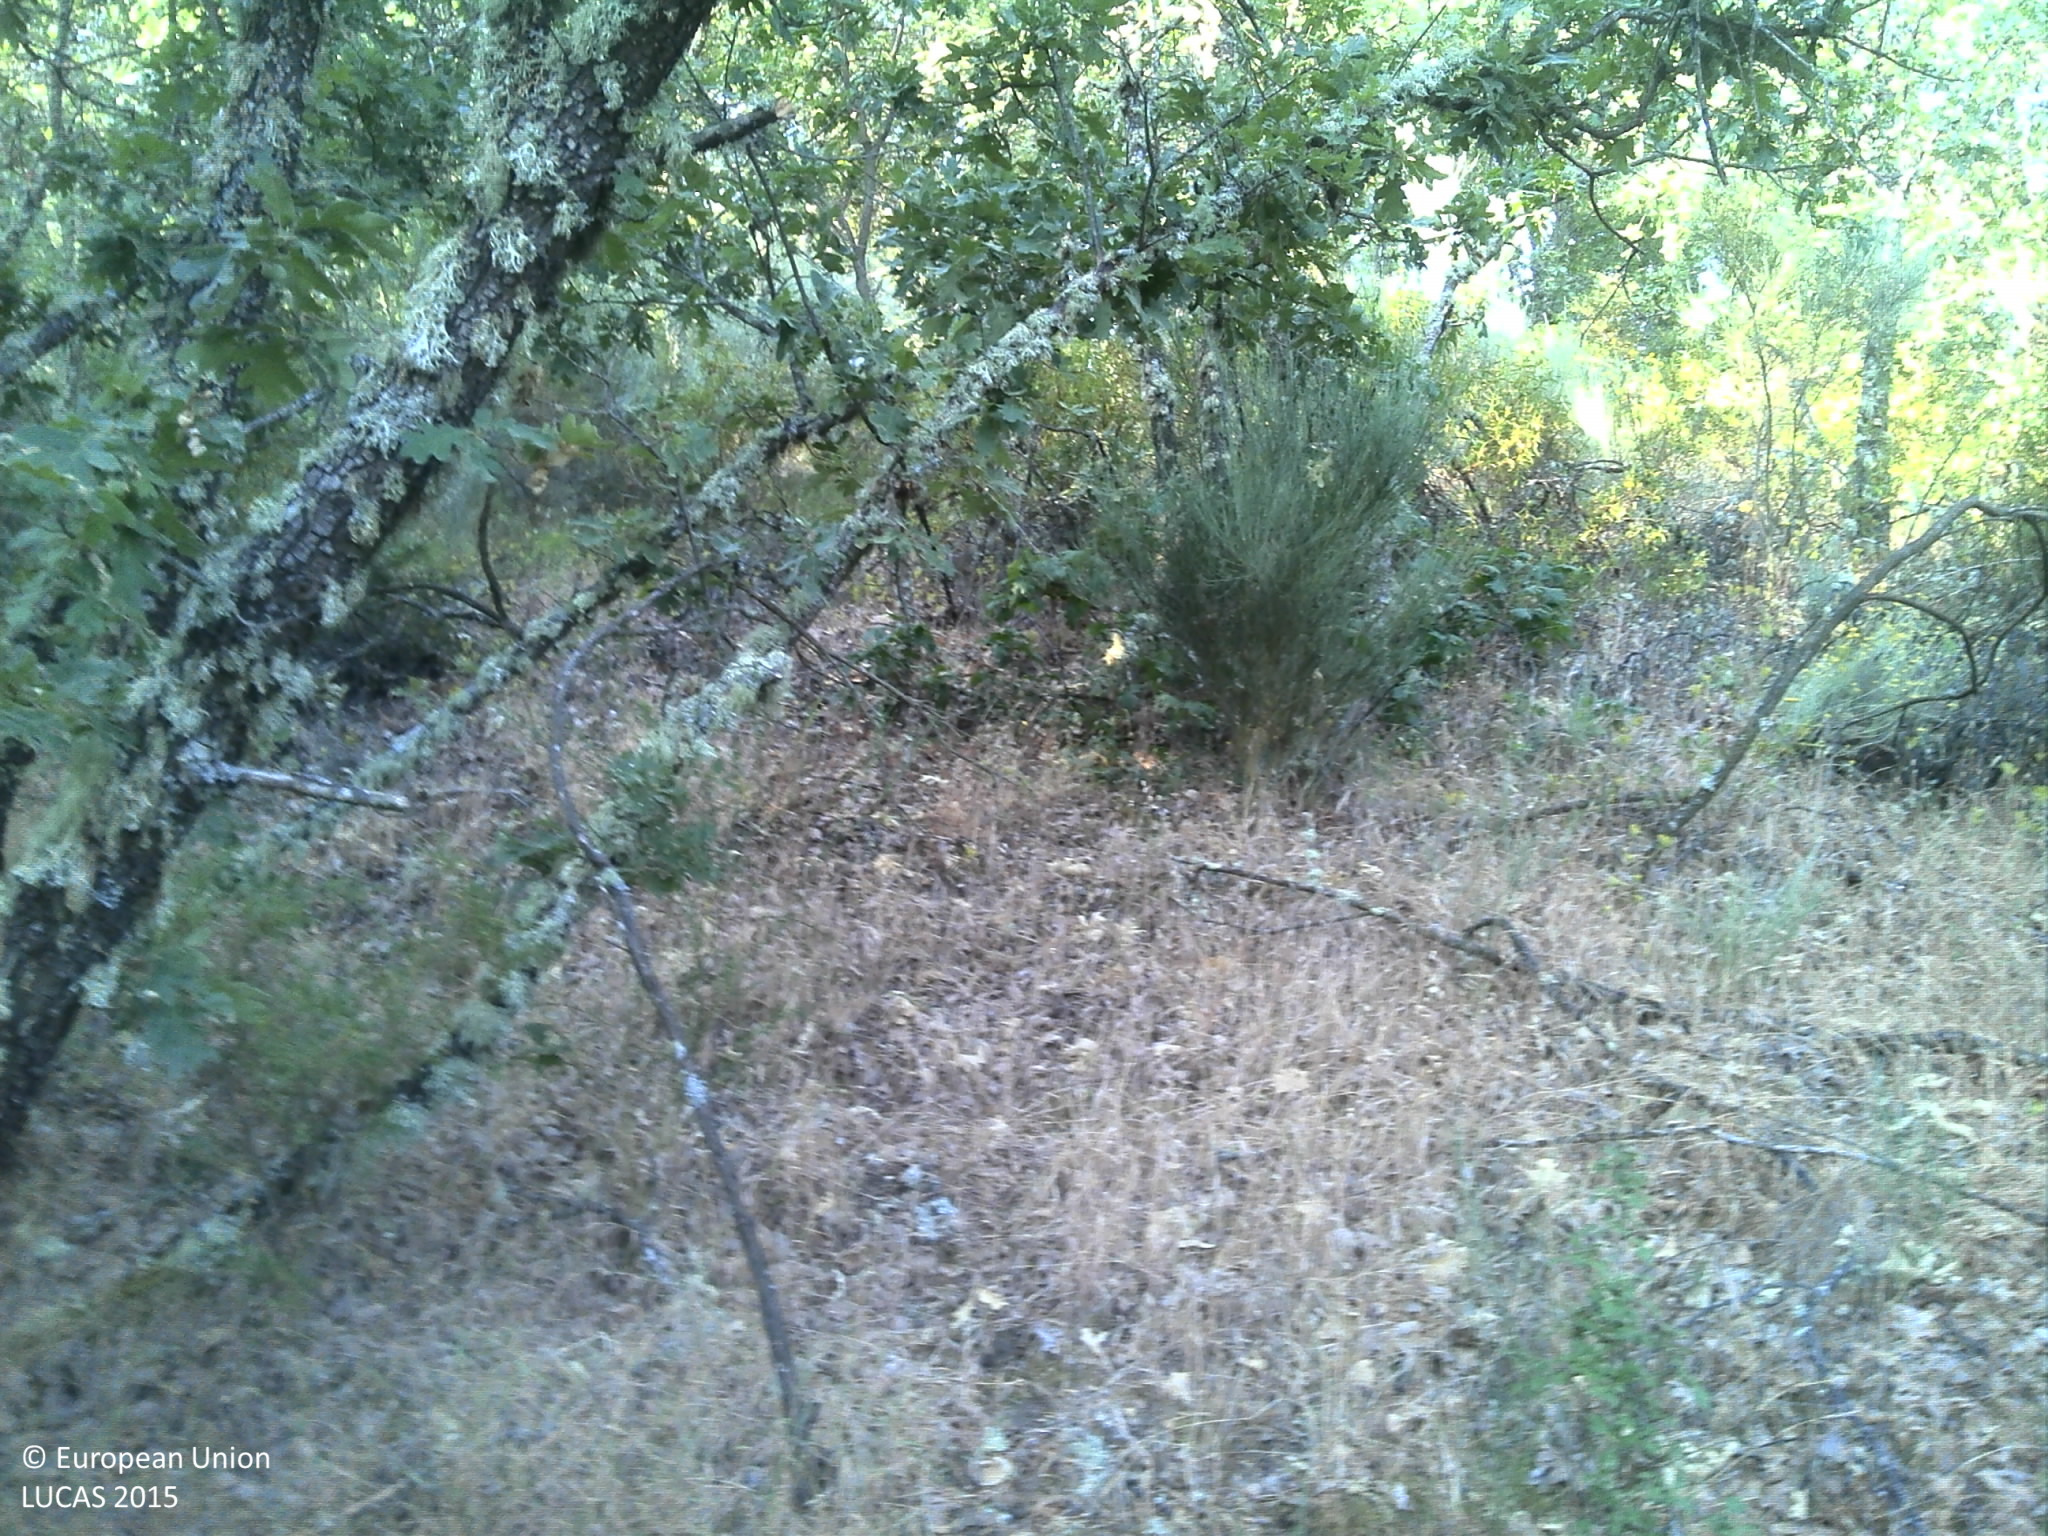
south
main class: Woodland
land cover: Broadleaved woodland
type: acidophilous oak and oak-birch forest
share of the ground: 50 - 75 %
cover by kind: broadleaved forest trees 65 %, shrubs 25 %, unconsolidated bare surface 5 %
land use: Forestry
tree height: > 5 m
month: June
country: PT
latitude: 40.2320
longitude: -7.3926
